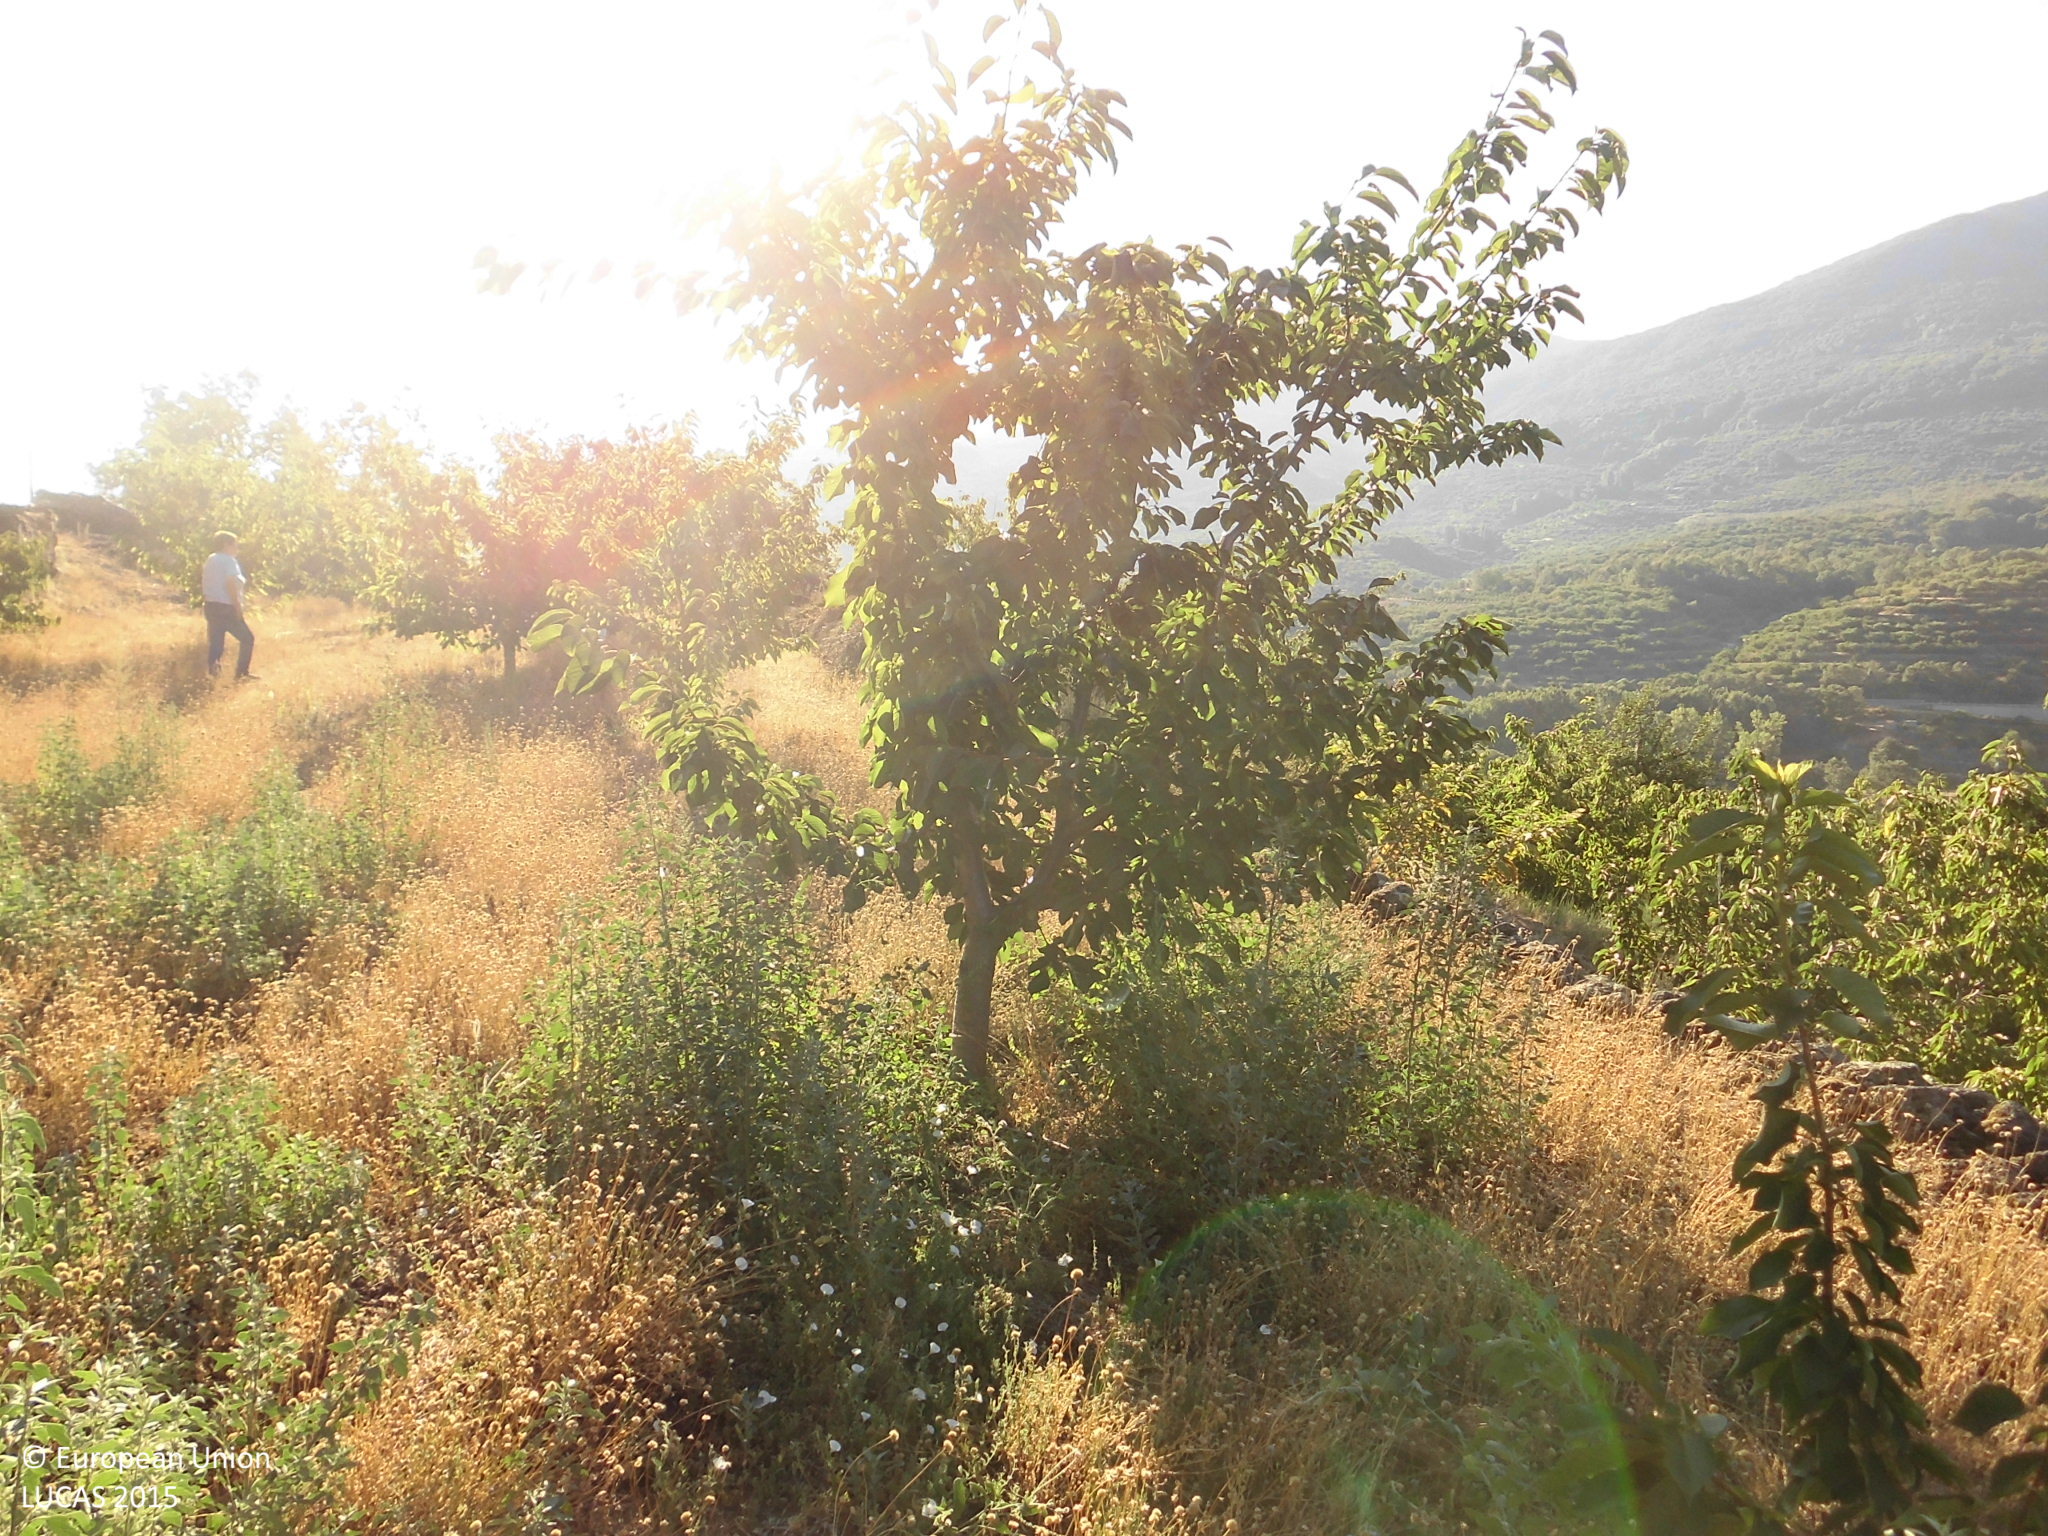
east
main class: Cropland
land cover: Cherry fruit
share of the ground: 25 - 50 %
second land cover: Grassland without tree/shrub cover
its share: > 75 %
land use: Agriculture (excluding fallow land and kitchen gardens)
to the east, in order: Cherry fruit; Grassland without tree/shrub cover; Cherry fruit; Dry stone walls; Paved roads, cycling and walking lanes; Cherry fruit; Dry stone walls; Cherry fruit; Dry stone walls; Paved roads, cycling and walking lanes; Abandoned hedges; Tracks; Ponds and wetlands; Fences; Cherry fruit
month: July
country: ES
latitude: 40.1635
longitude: -5.8612
